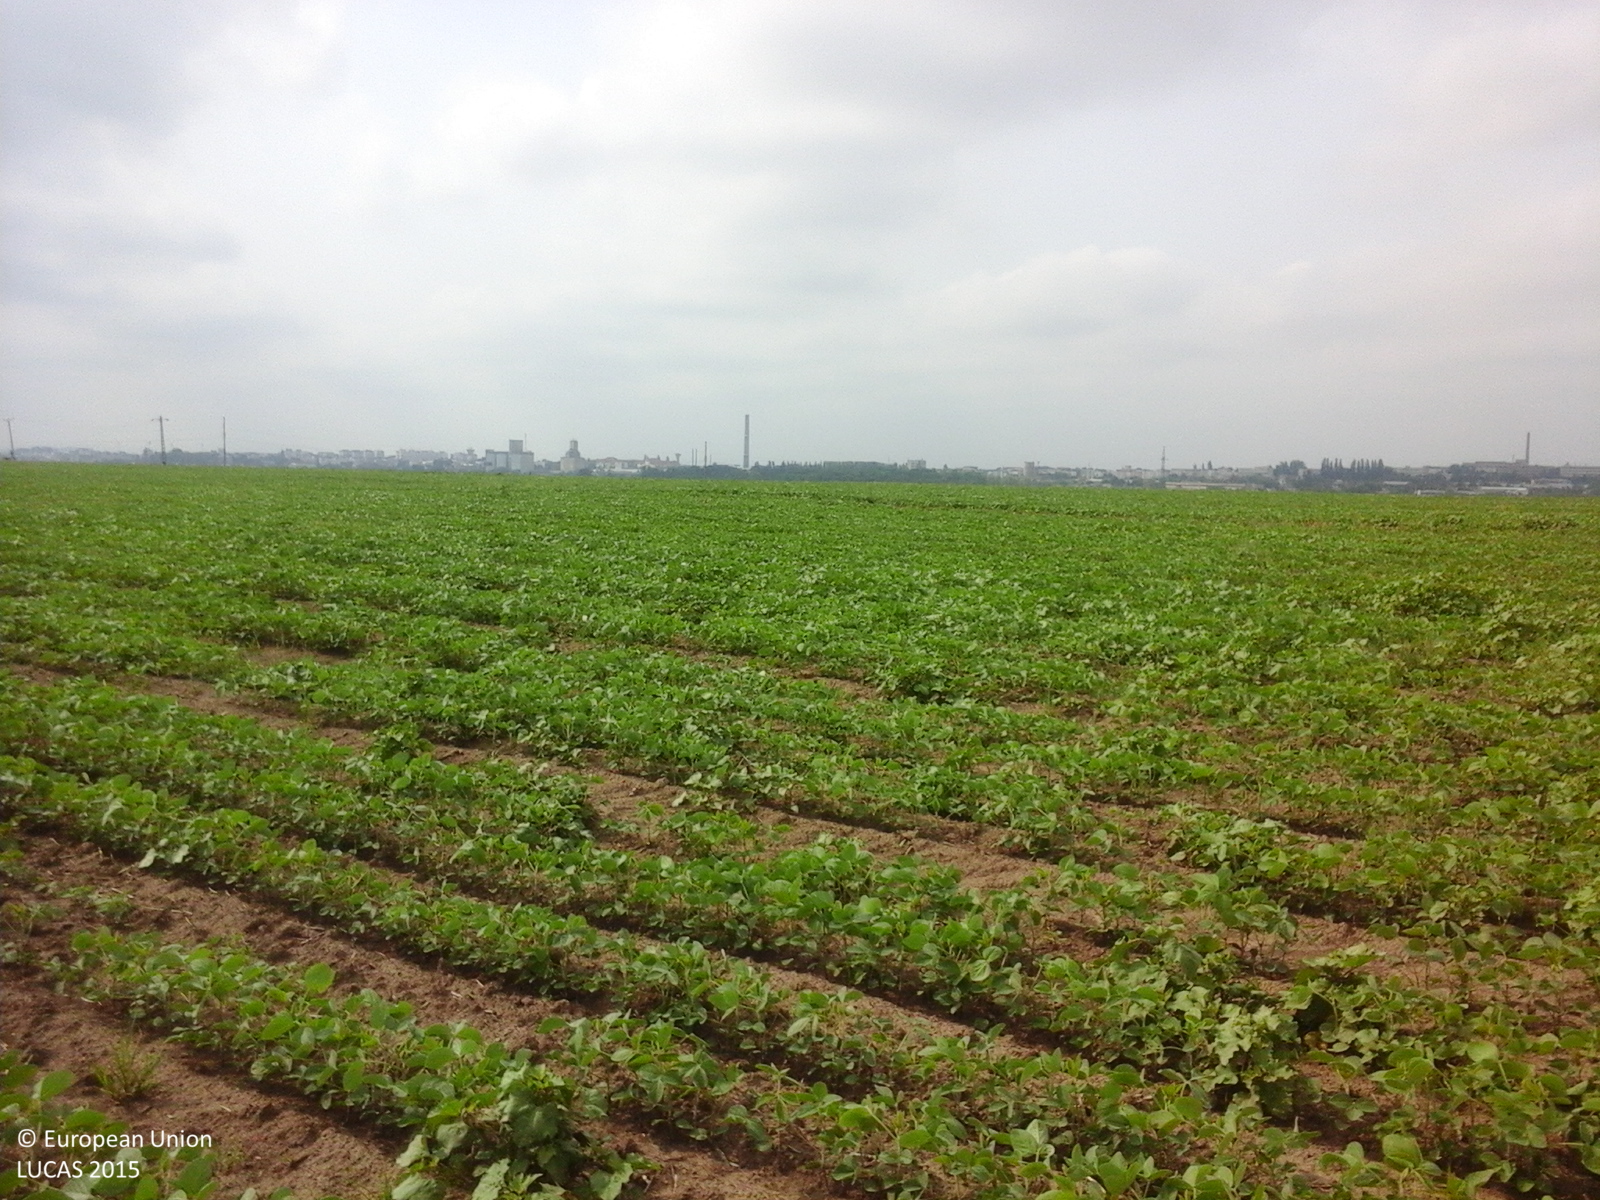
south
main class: Cropland
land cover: Soya
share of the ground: 50 - 75 %
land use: Agriculture (excluding fallow land and kitchen gardens)
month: June
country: RO
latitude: 47.7754
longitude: 26.6287
